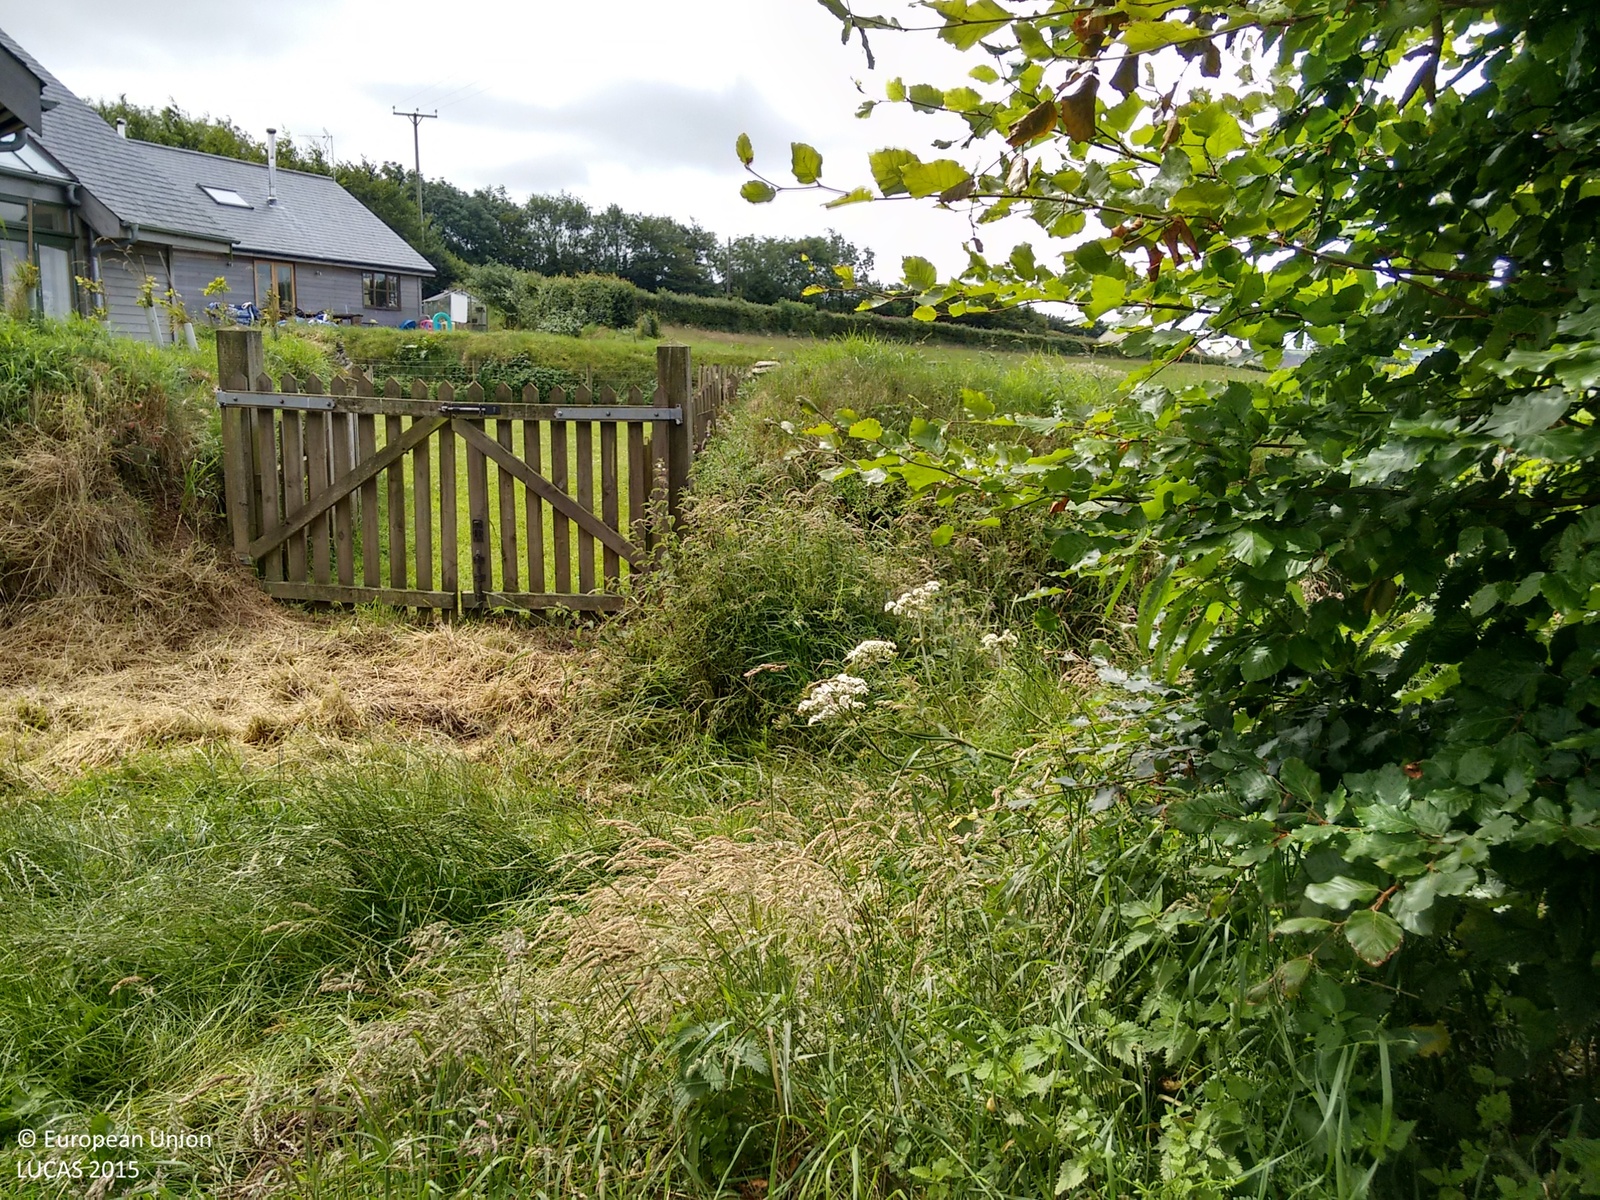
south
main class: Grassland
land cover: Grassland without tree/shrub cover
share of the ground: > 75 %
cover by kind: herbaceous plants 100 %
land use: Agriculture (excluding fallow land and kitchen gardens)
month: July
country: GB
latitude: 51.1415
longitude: -3.5350
